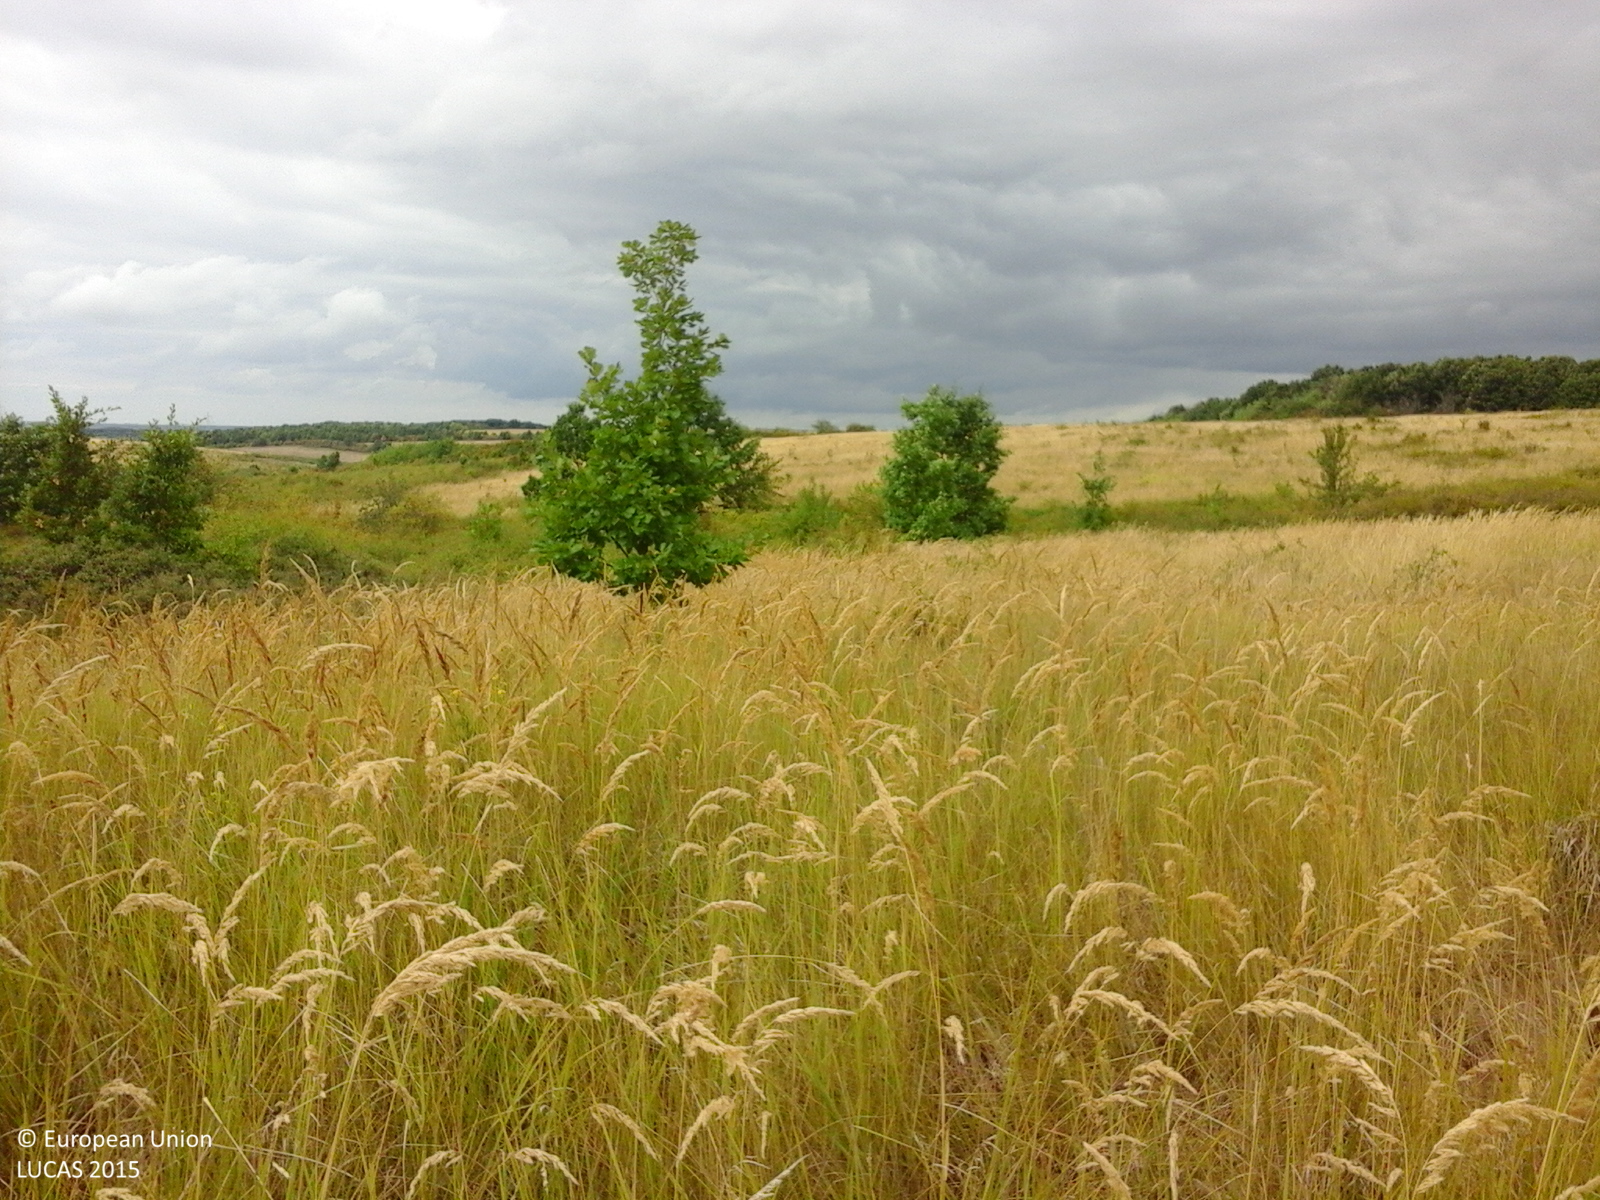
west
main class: Grassland
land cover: Grassland with sparse tree/shrub cover
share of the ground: > 75 %
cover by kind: herbaceous plants 85 %, shrubs 10 %, broadleaved forest trees 5 %
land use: Fallow land
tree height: < 5 m
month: August
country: RO
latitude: 45.4622
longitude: 21.6075
